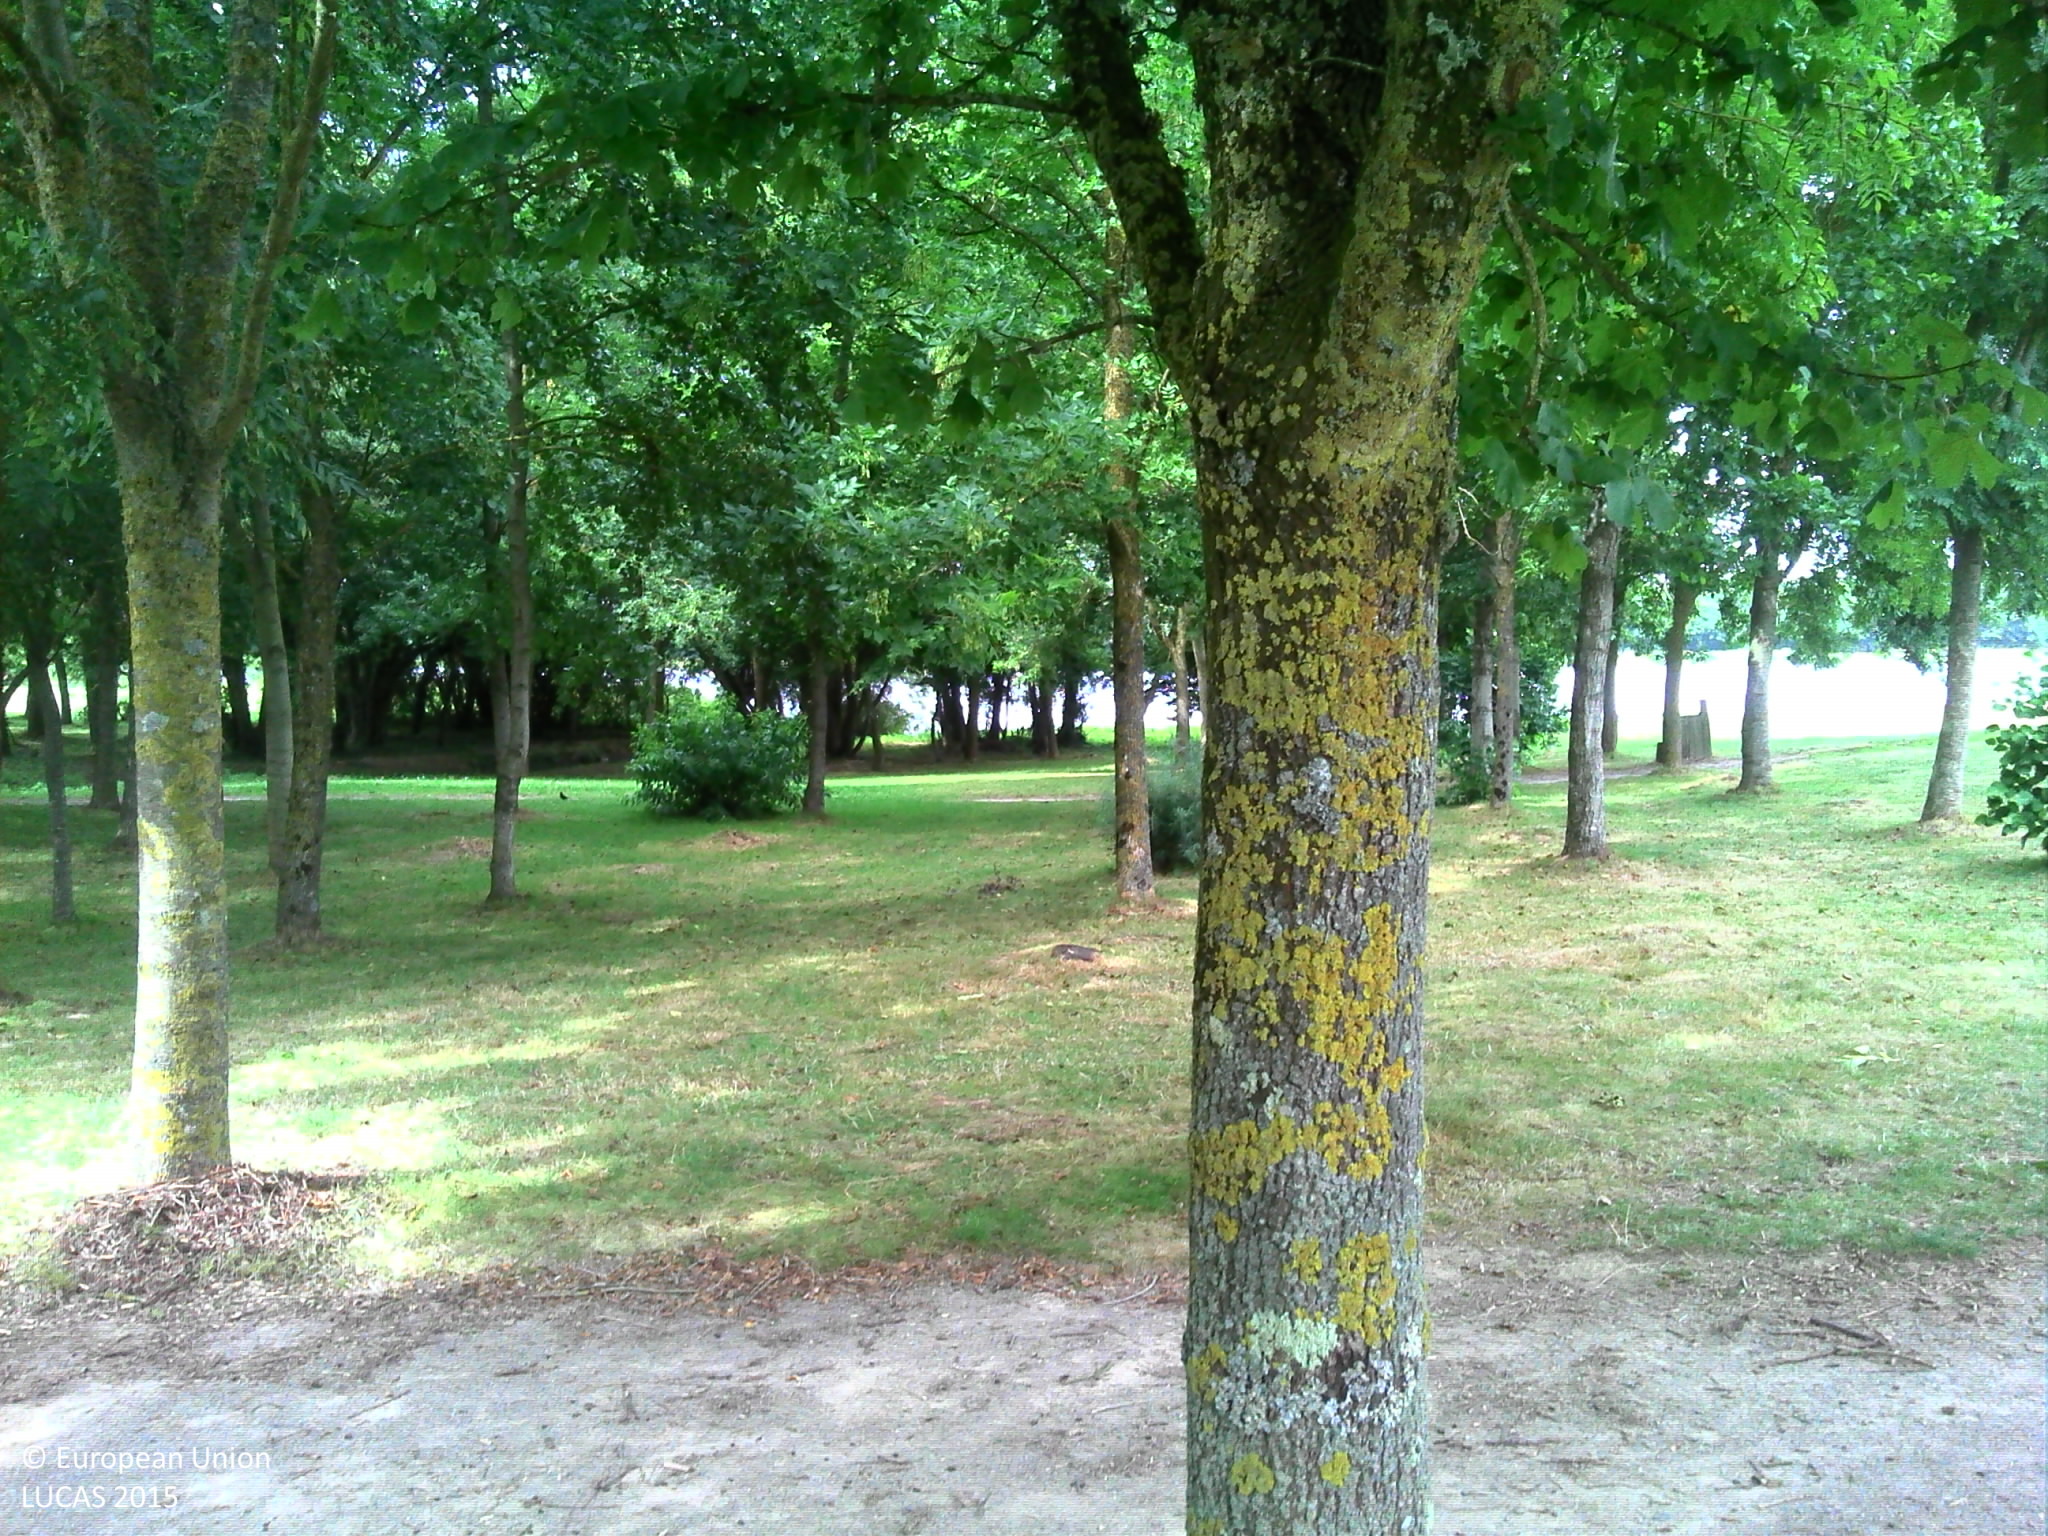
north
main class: Woodland
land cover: Broadleaved woodland
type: mesophytic deciduous forest
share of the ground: > 75 %
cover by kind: broadleaved forest trees 95 %, herbaceous plants 5 %
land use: Amenities, museums, leisure
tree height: > 5 m
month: July
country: FR
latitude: 47.8642
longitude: -1.0674
